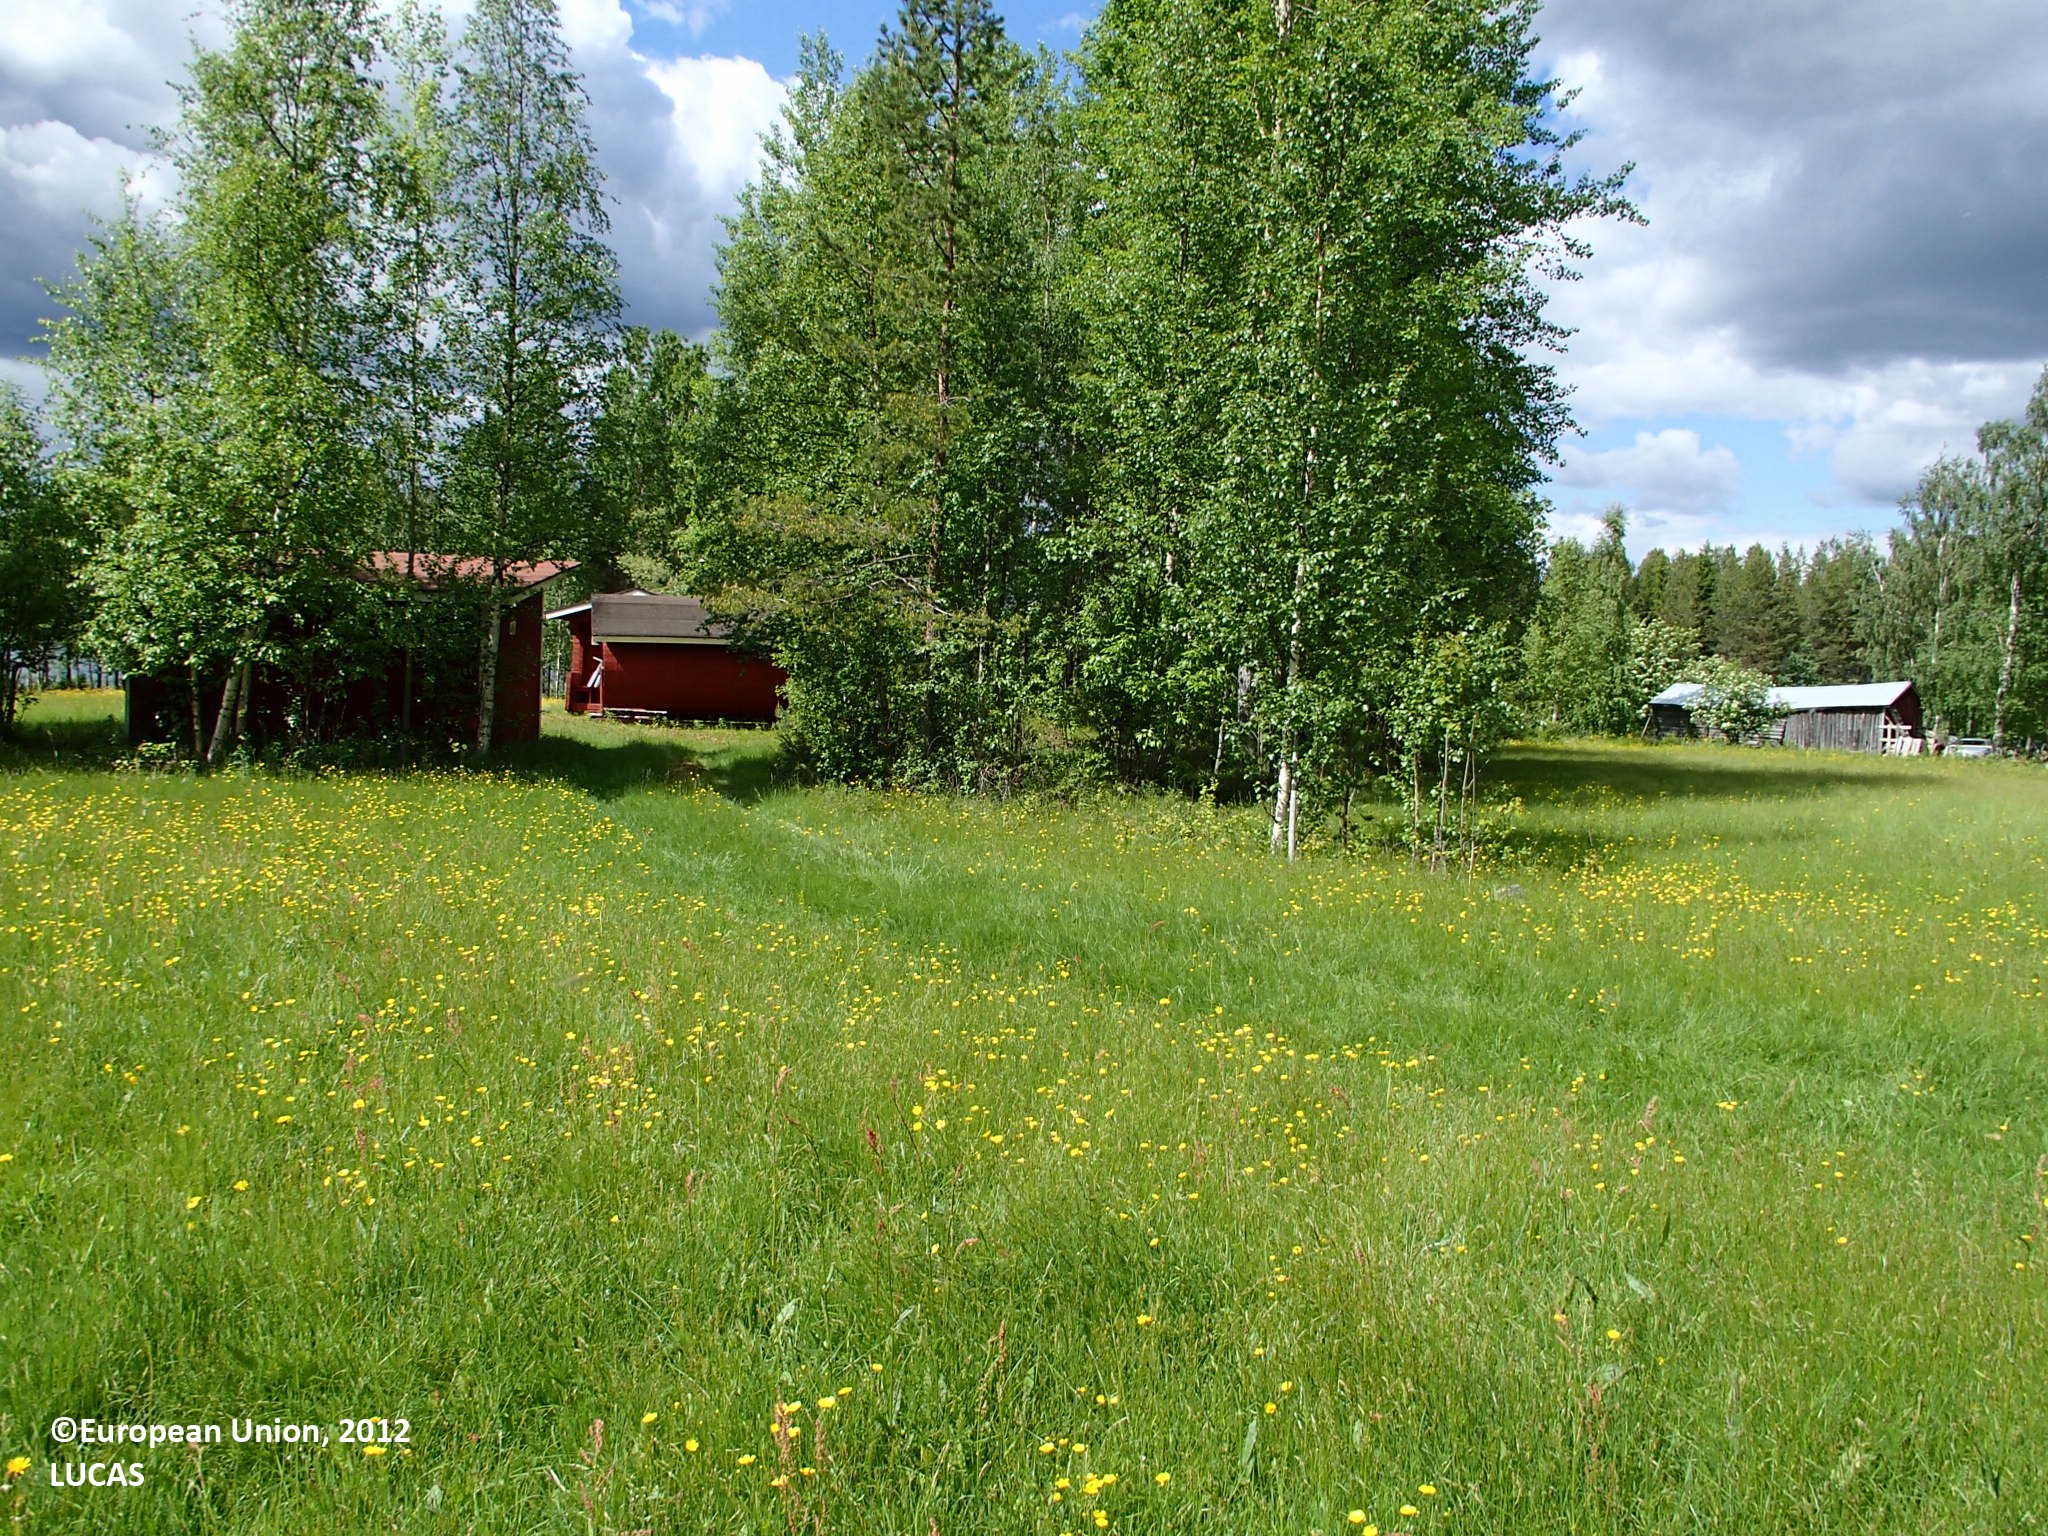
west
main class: Grassland
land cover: Grassland without tree/shrub cover
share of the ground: > 75 %
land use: Agriculture (excluding fallow land and kitchen gardens)
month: June
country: FI
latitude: 66.5173
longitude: 27.2205
